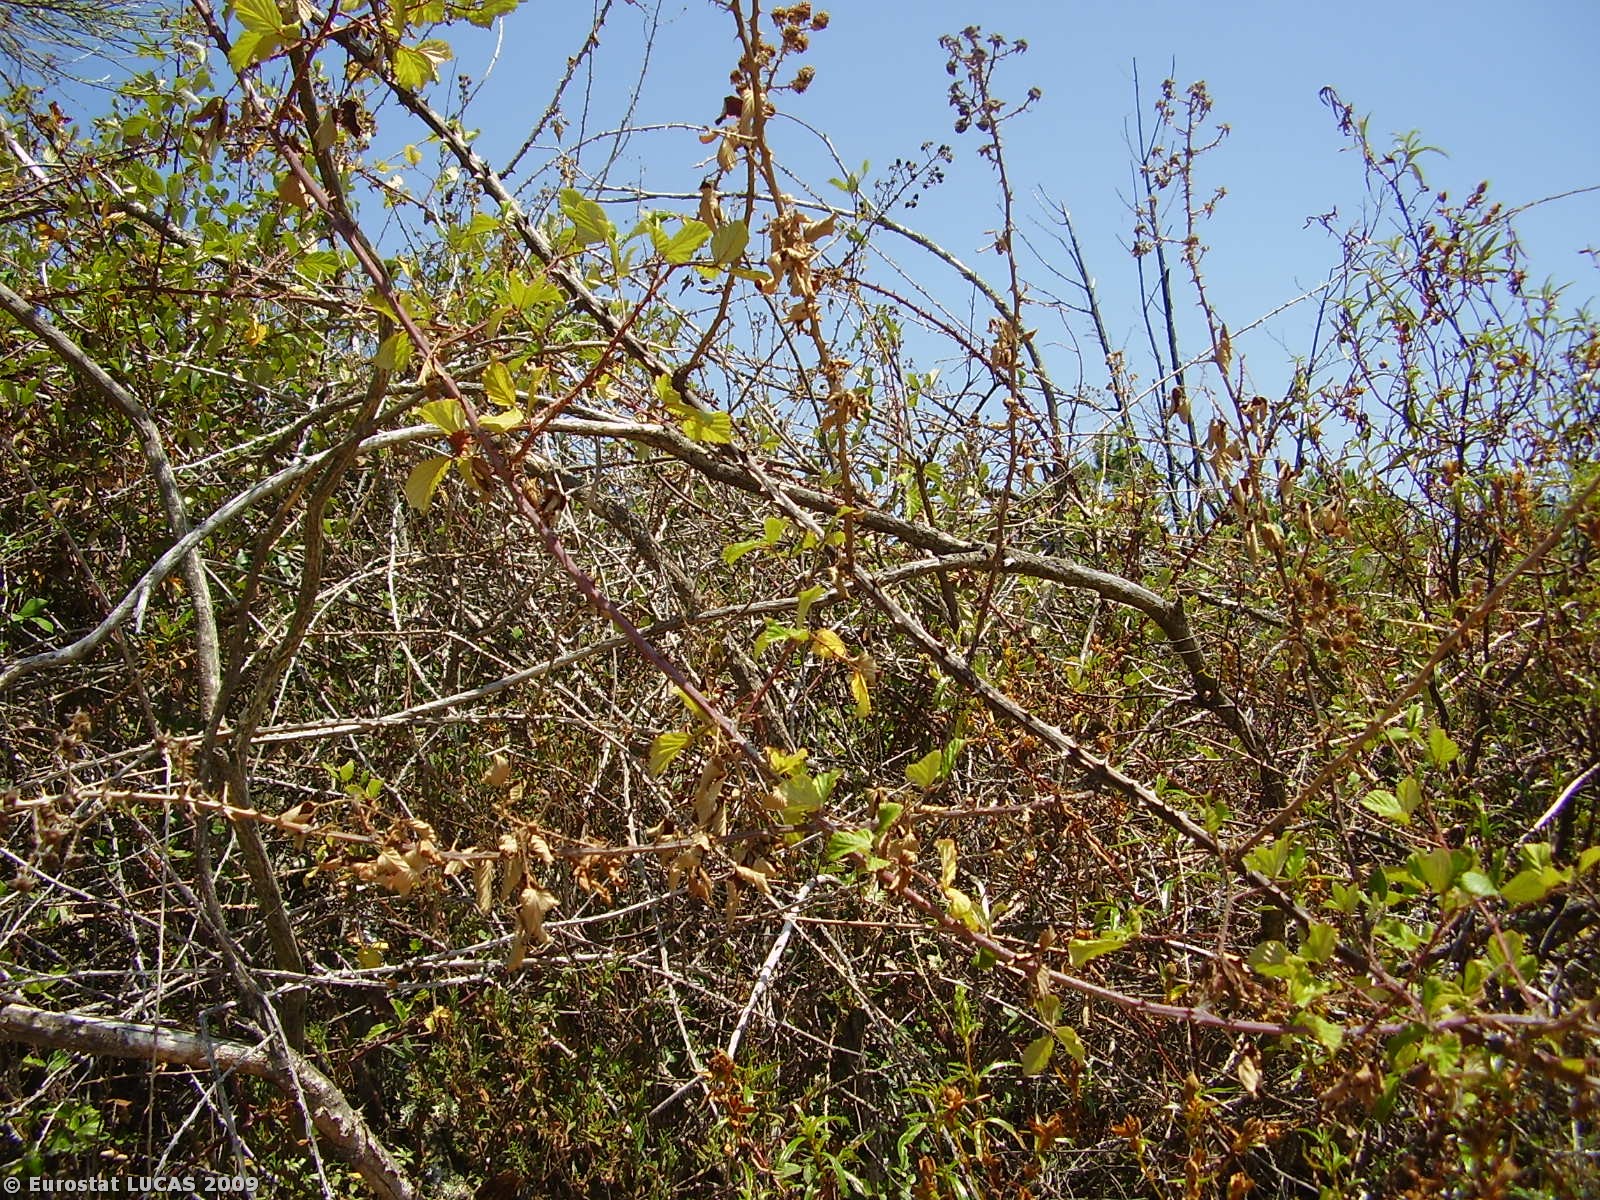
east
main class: Shrubland
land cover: Shrubland with sparse tree cover
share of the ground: 50 - 75 %
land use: Unused
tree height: > 5 m
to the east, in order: Shrubland with sparse tree cover; Artificial constructions in urban areas; Shrubland with sparse tree cover; Tracks; Shrubland with sparse tree cover; Tracks; Shrubland with sparse tree cover
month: July
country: PT
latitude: 41.4431
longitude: -7.3212
